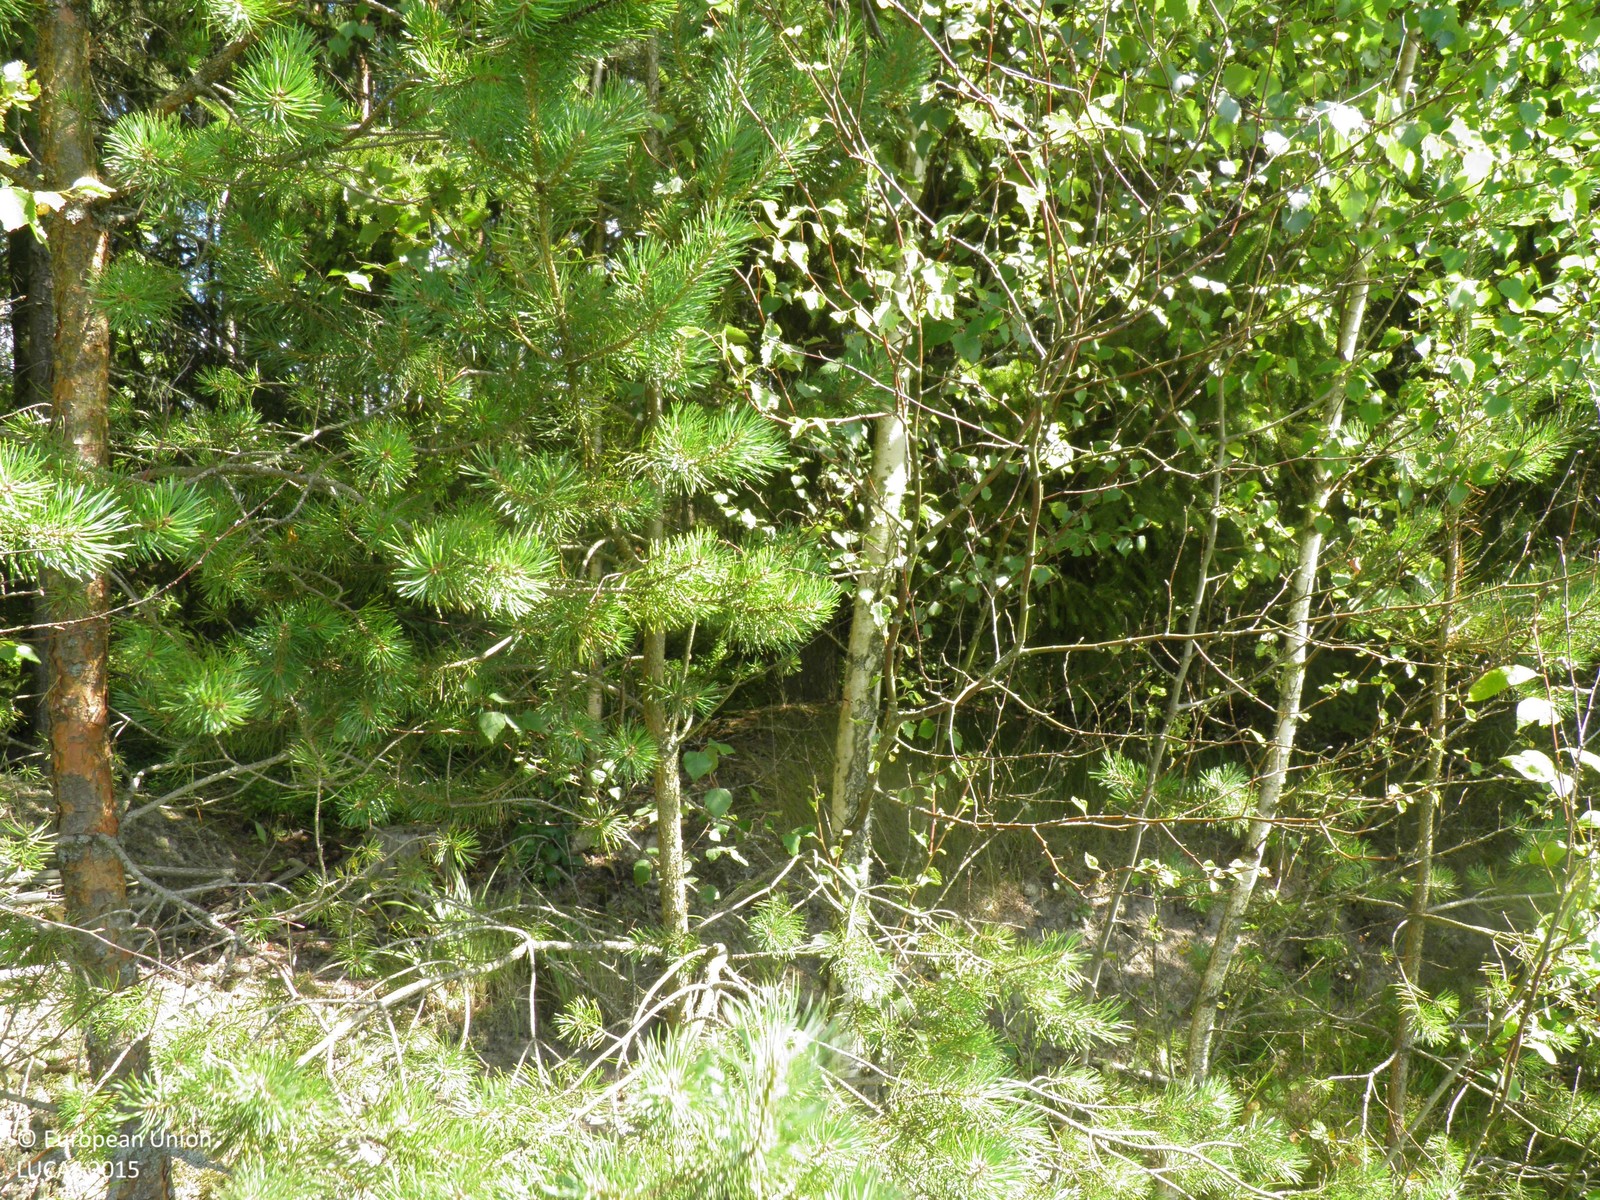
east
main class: Cropland
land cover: Barley
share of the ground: > 75 %
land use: Agriculture (excluding fallow land and kitchen gardens)
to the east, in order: Barley; Ditches and canals; Other coniferous woodland; Spontaneously vegetated surfaces; Shrubland with sparse tree cover; Tracks; Shrubland with sparse tree cover
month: August
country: FI
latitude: 60.9381
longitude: 22.8997
